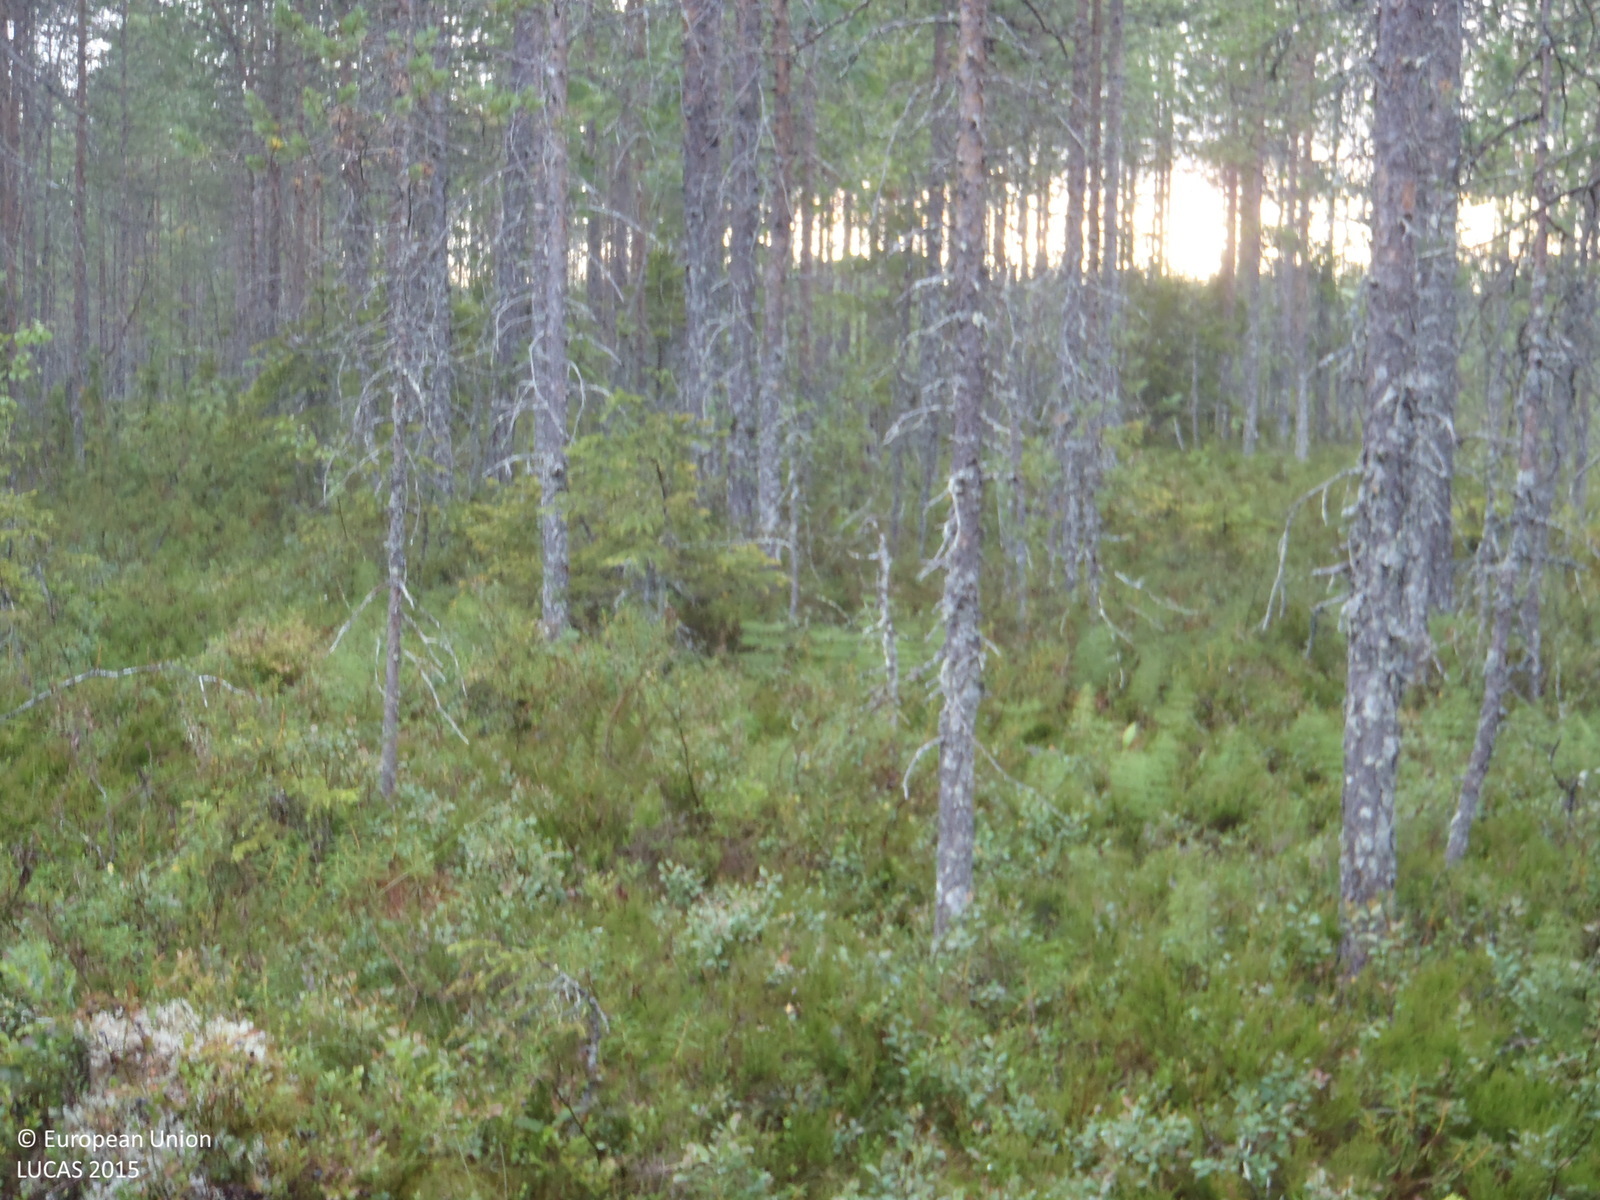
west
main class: Woodland
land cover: Pine dominated mixed woodland
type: mire and swamp forests
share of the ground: > 75 %
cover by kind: coniferous forest trees 55 %, broadleaved forest trees 20 %, shrubs 15 %, herbaceous plants 5 %, lichens and mosses 5 %
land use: Forestry
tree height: > 5 m
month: July
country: FI
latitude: 64.7827
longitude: 27.2337
